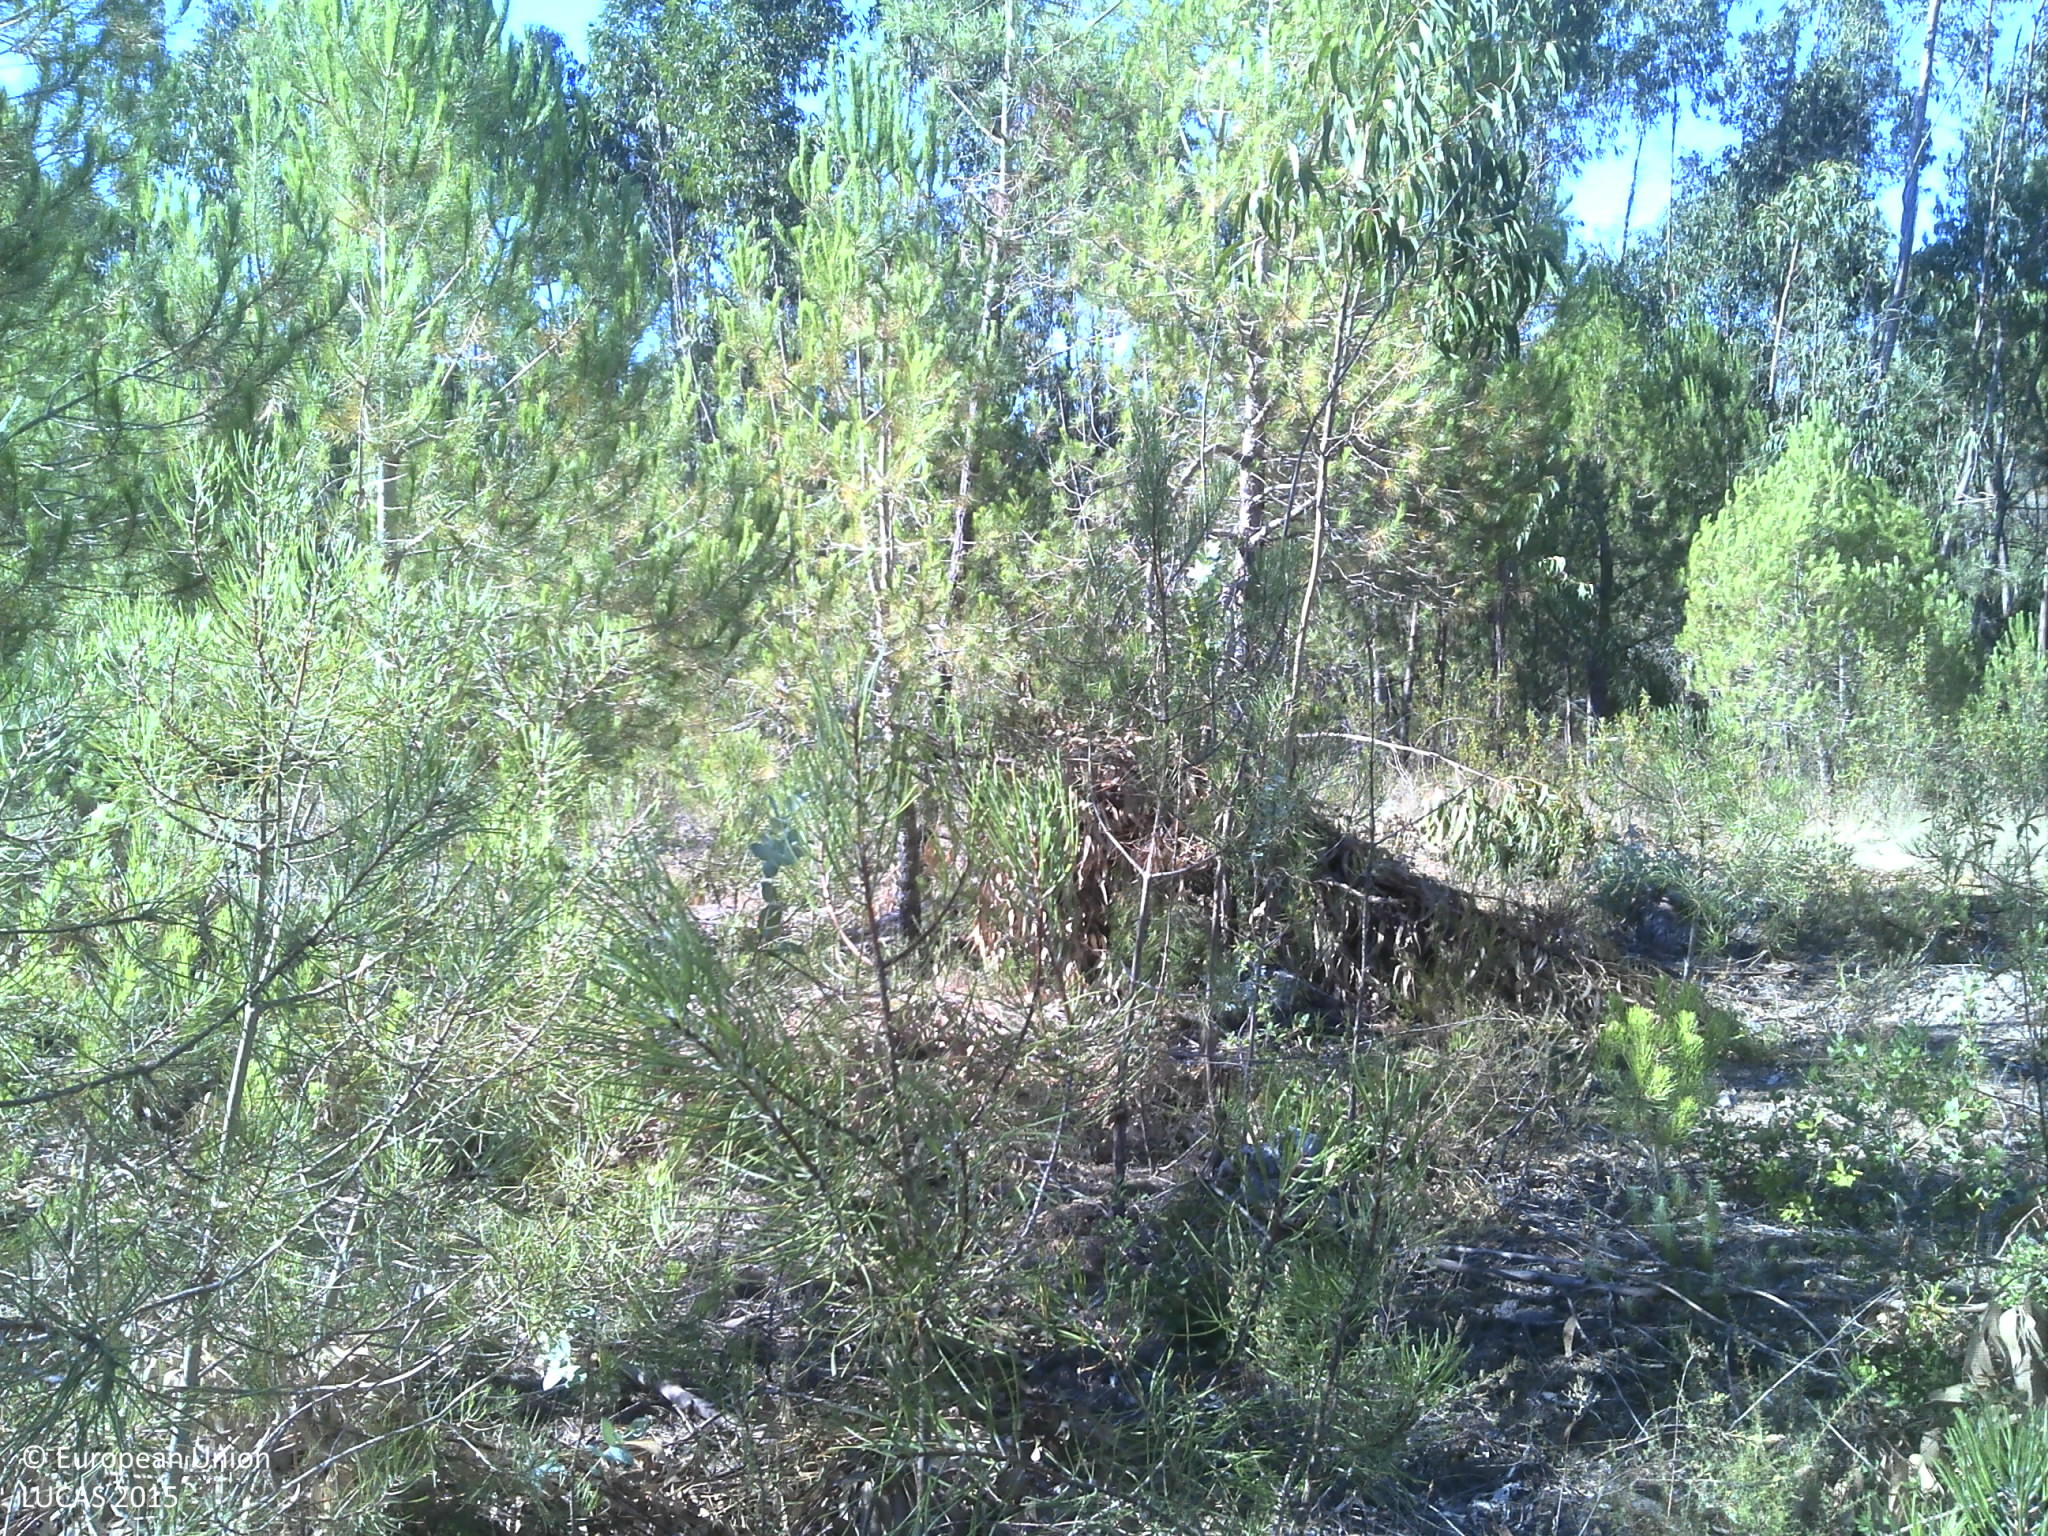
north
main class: Woodland
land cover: Pine dominated coniferous woodland
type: coniferous forest of the mediterranean region
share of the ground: 25 - 50 %
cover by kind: coniferous forest trees 50 %, unconsolidated bare surface 45 %, shrubs 5 %
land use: Forestry
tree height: < 5 m
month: July
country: PT
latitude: 39.0383
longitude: -8.6328
